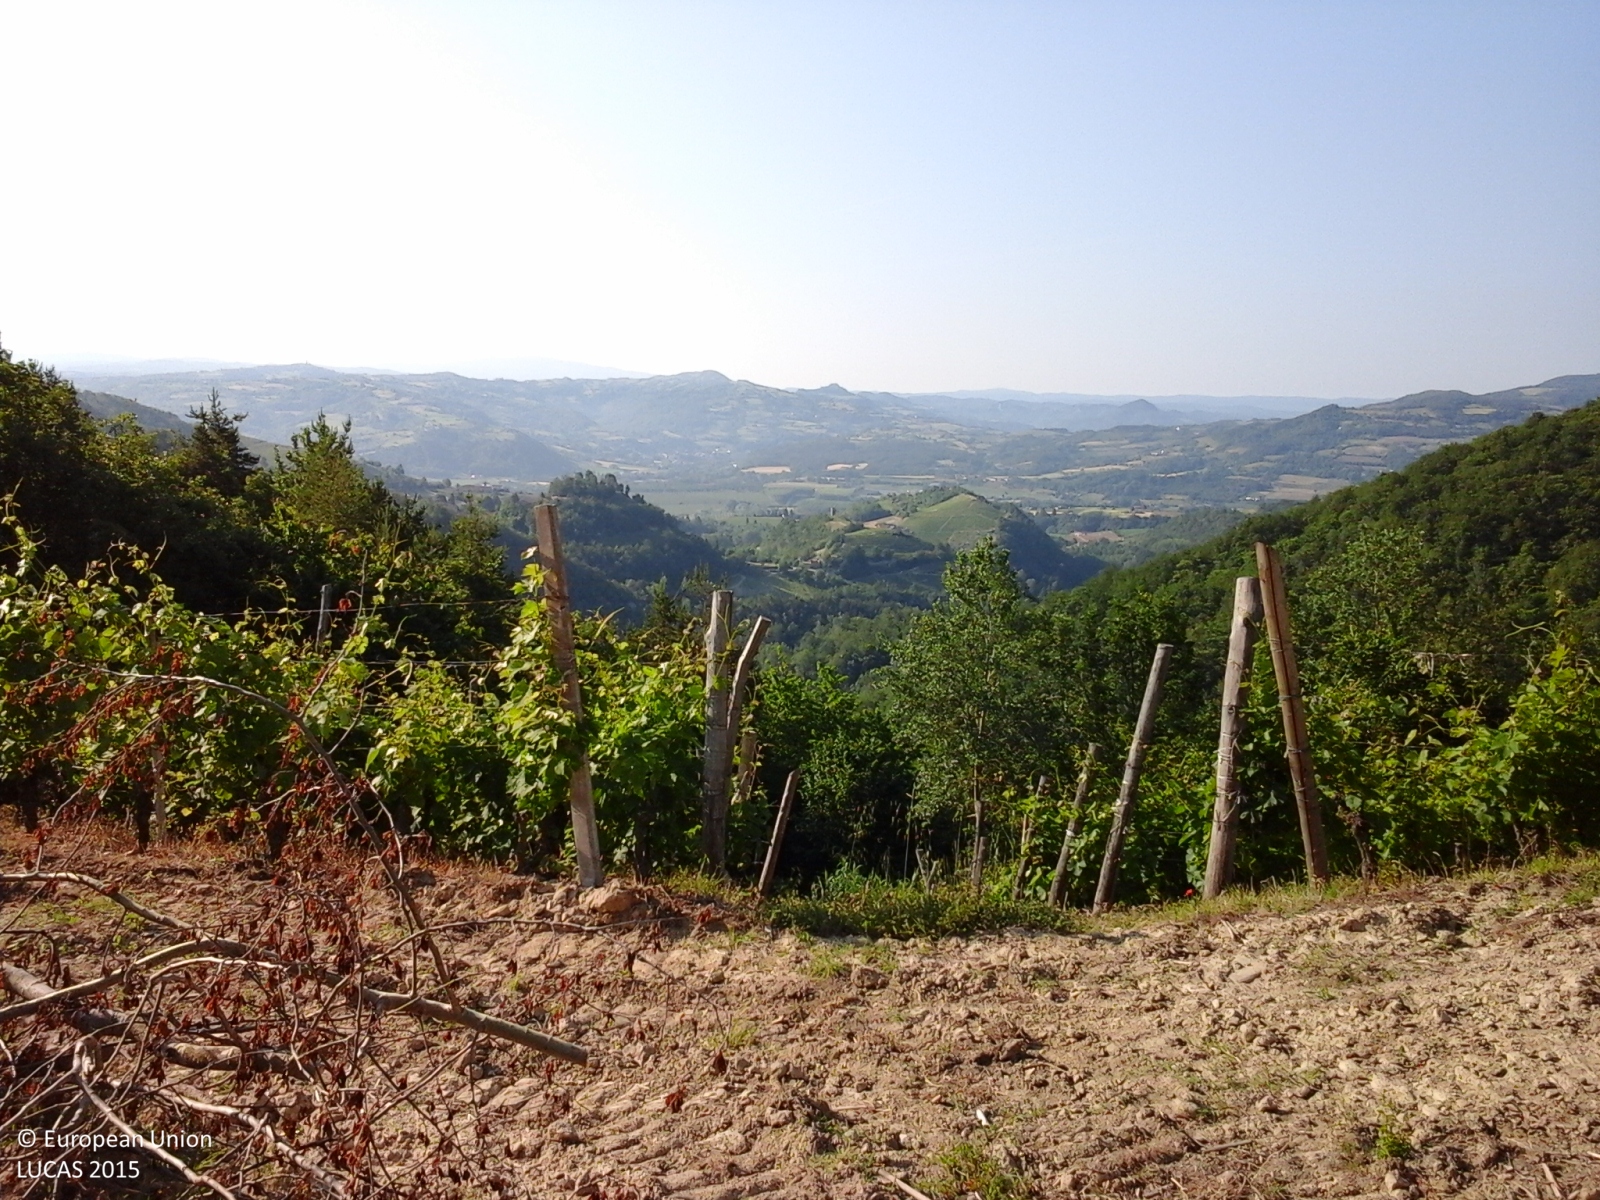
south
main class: Woodland
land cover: Broadleaved woodland
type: mesophytic deciduous forest
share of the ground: > 75 %
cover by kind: broadleaved forest trees 95 %, shrubs 5 %
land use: Forestry
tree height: > 5 m
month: June
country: IT
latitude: 44.6798
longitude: 8.3255
